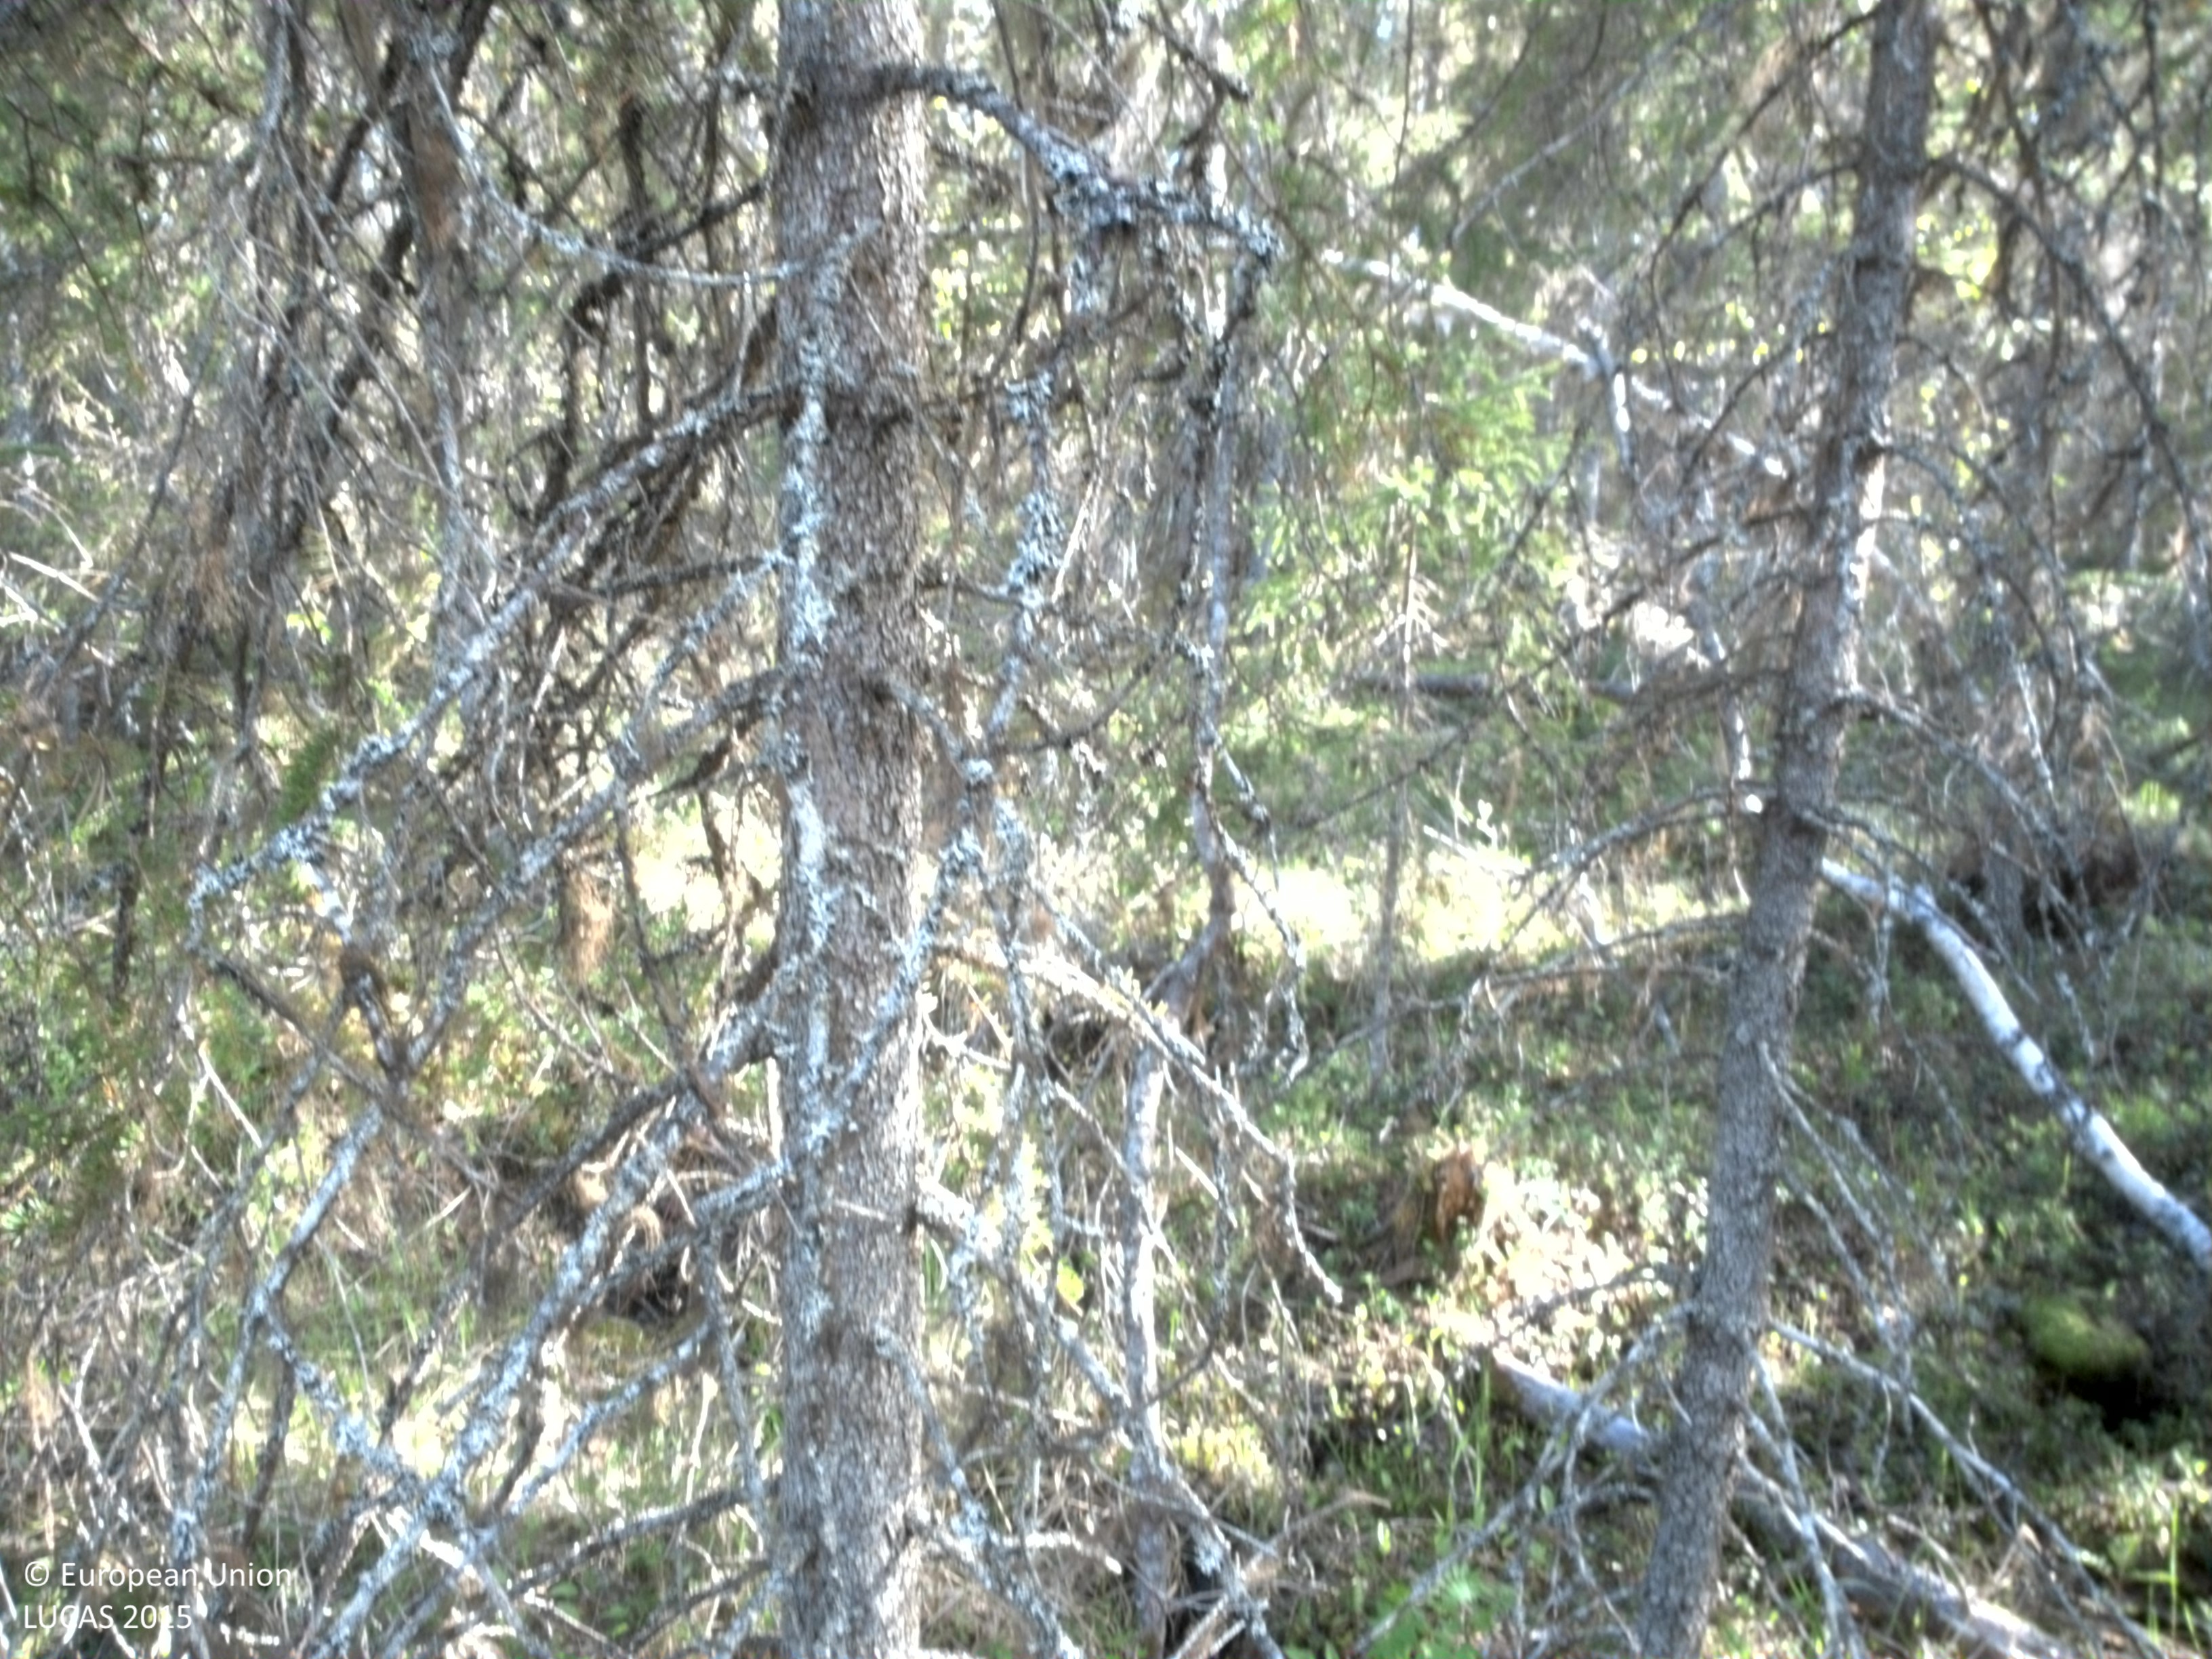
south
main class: Woodland
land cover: Spruce dominated mixed woodland
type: boreal forest
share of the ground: 25 - 50 %
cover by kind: herbaceous plants 45 %, coniferous forest trees 30 %, broadleaved forest trees 10 %, lichens and mosses 5 %
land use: Forestry
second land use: Amenities, museums, leisure
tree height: > 5 m
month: June
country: SE
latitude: 66.7012
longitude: 21.8578
